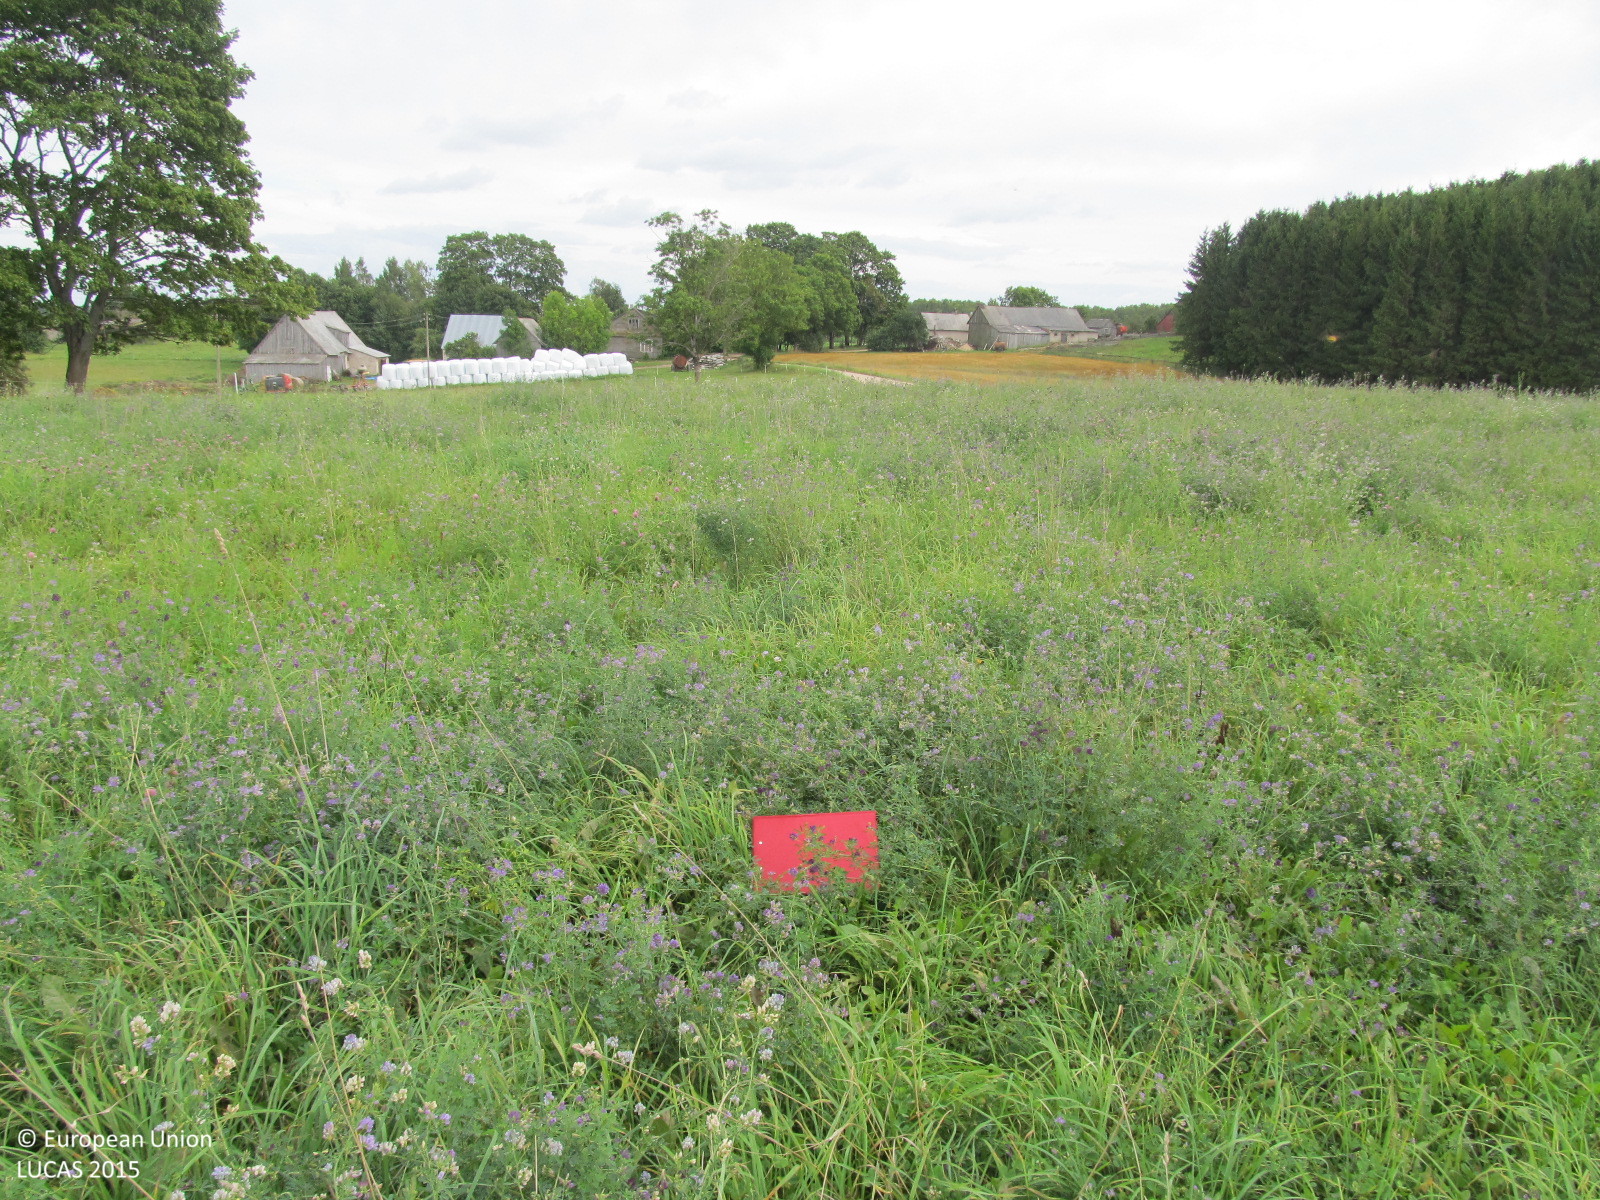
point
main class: Grassland
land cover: Grassland without tree/shrub cover
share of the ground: > 75 %
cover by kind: herbaceous plants 100 %
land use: Agriculture (excluding fallow land and kitchen gardens)
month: September
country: LT
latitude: 55.7043
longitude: 22.6502
